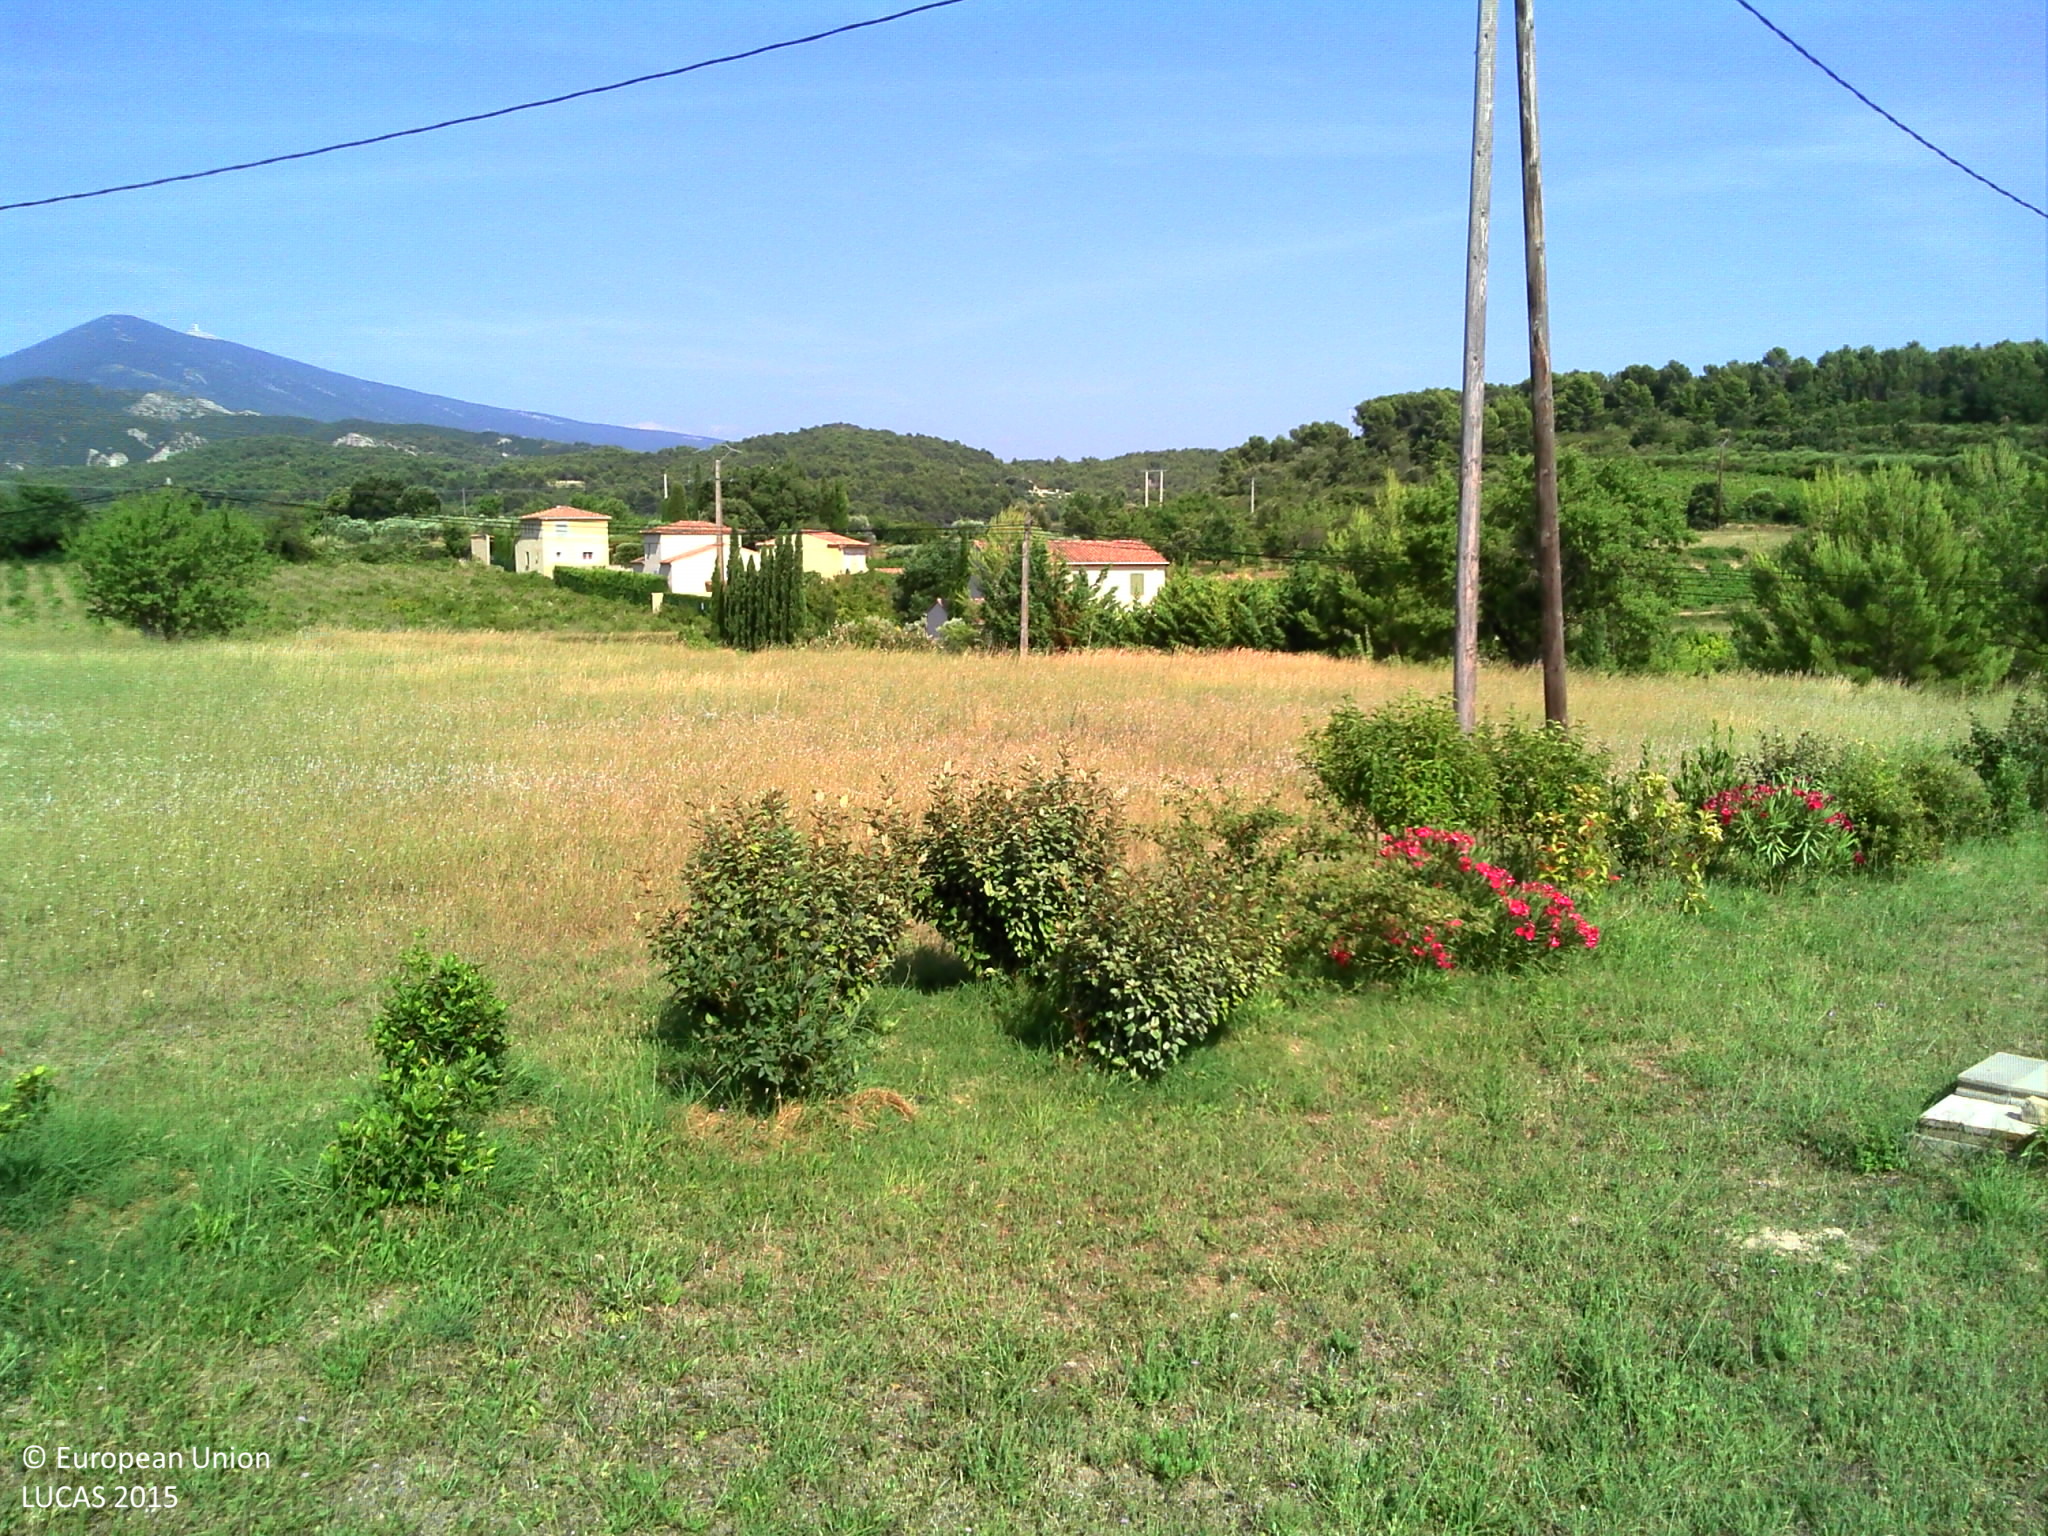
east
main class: Grassland
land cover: Grassland without tree/shrub cover
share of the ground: > 75 %
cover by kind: herbaceous plants 100 %
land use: Residential
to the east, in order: Grassland without tree/shrub cover; Managed hedges; Electric lines; Grassland without tree/shrub cover; Managed hedges; Electric lines; Paved roads, cycling and walking lanes; Grassland without tree/shrub cover; Electric lines; Vineyards; Artificial constructions in urban areas; Vineyards
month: July
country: FR
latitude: 44.1443
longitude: 5.0950
